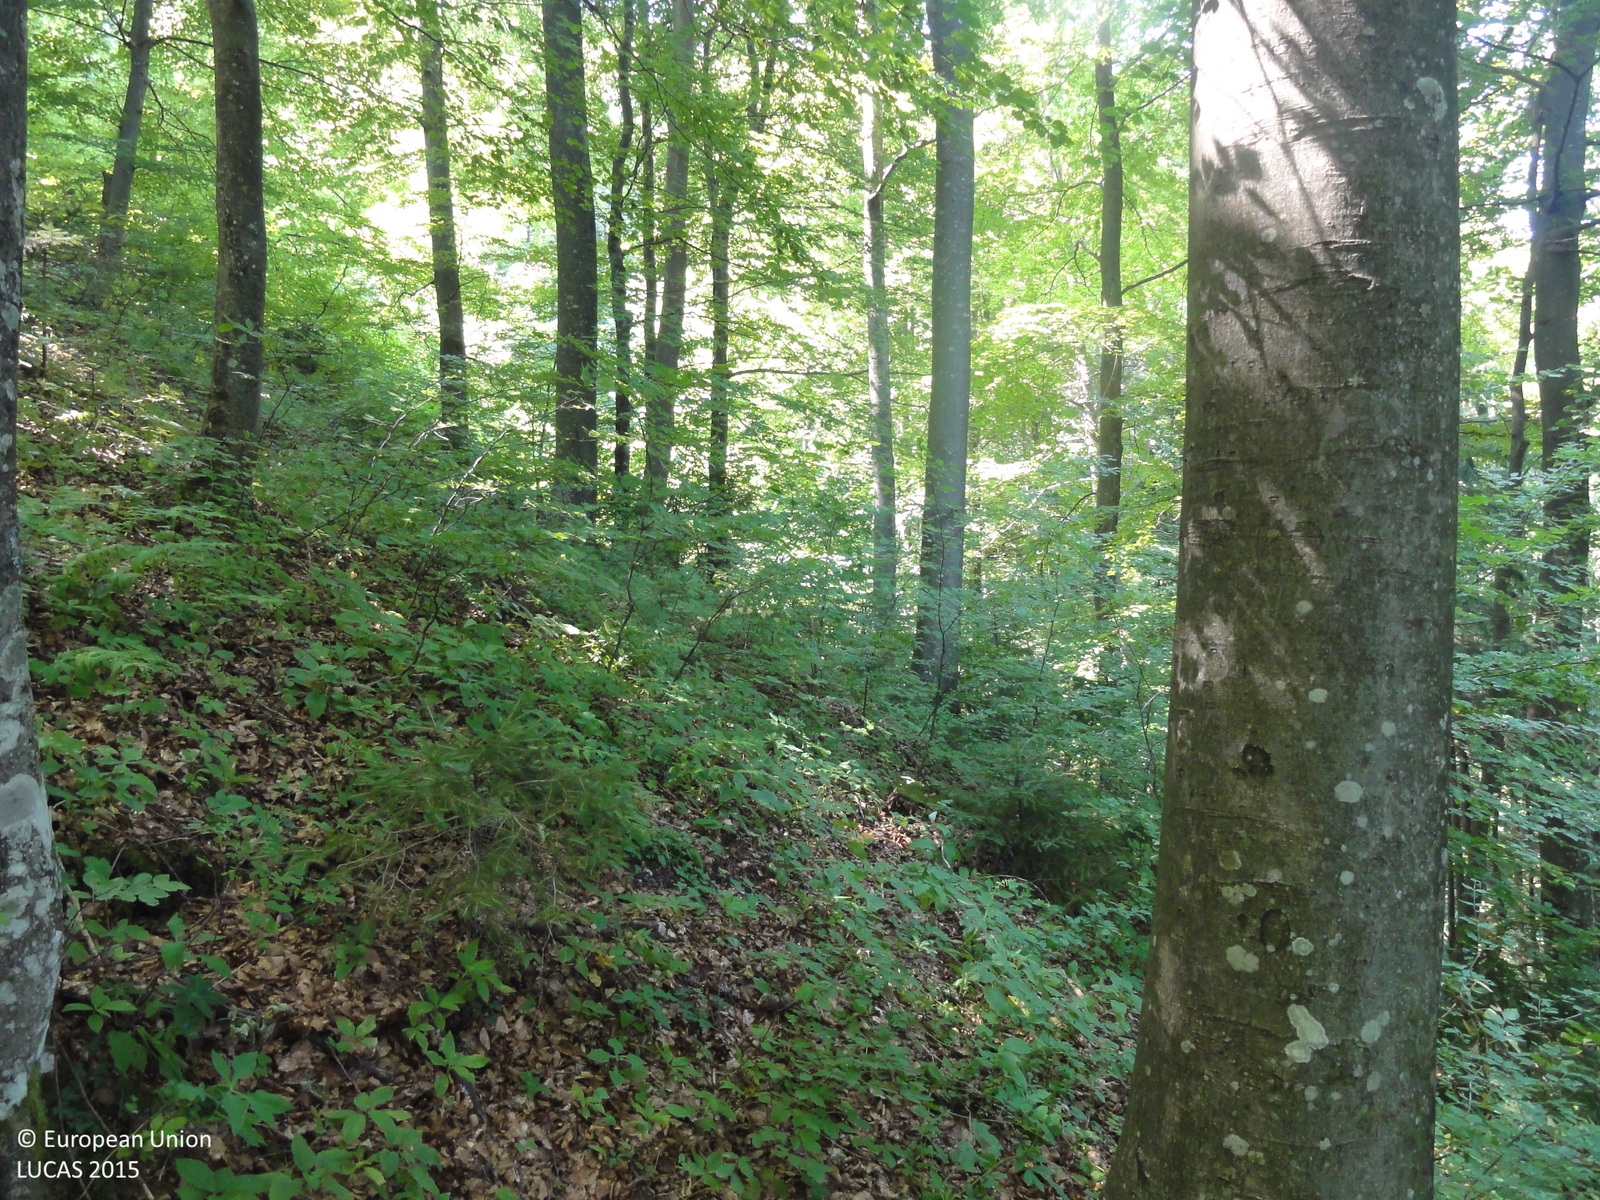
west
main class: Woodland
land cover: Broadleaved woodland
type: mountainous beech forest
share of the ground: > 75 %
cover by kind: broadleaved forest trees 100 %
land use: Forestry
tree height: > 5 m
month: August
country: SI
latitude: 46.0515
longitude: 15.0504
